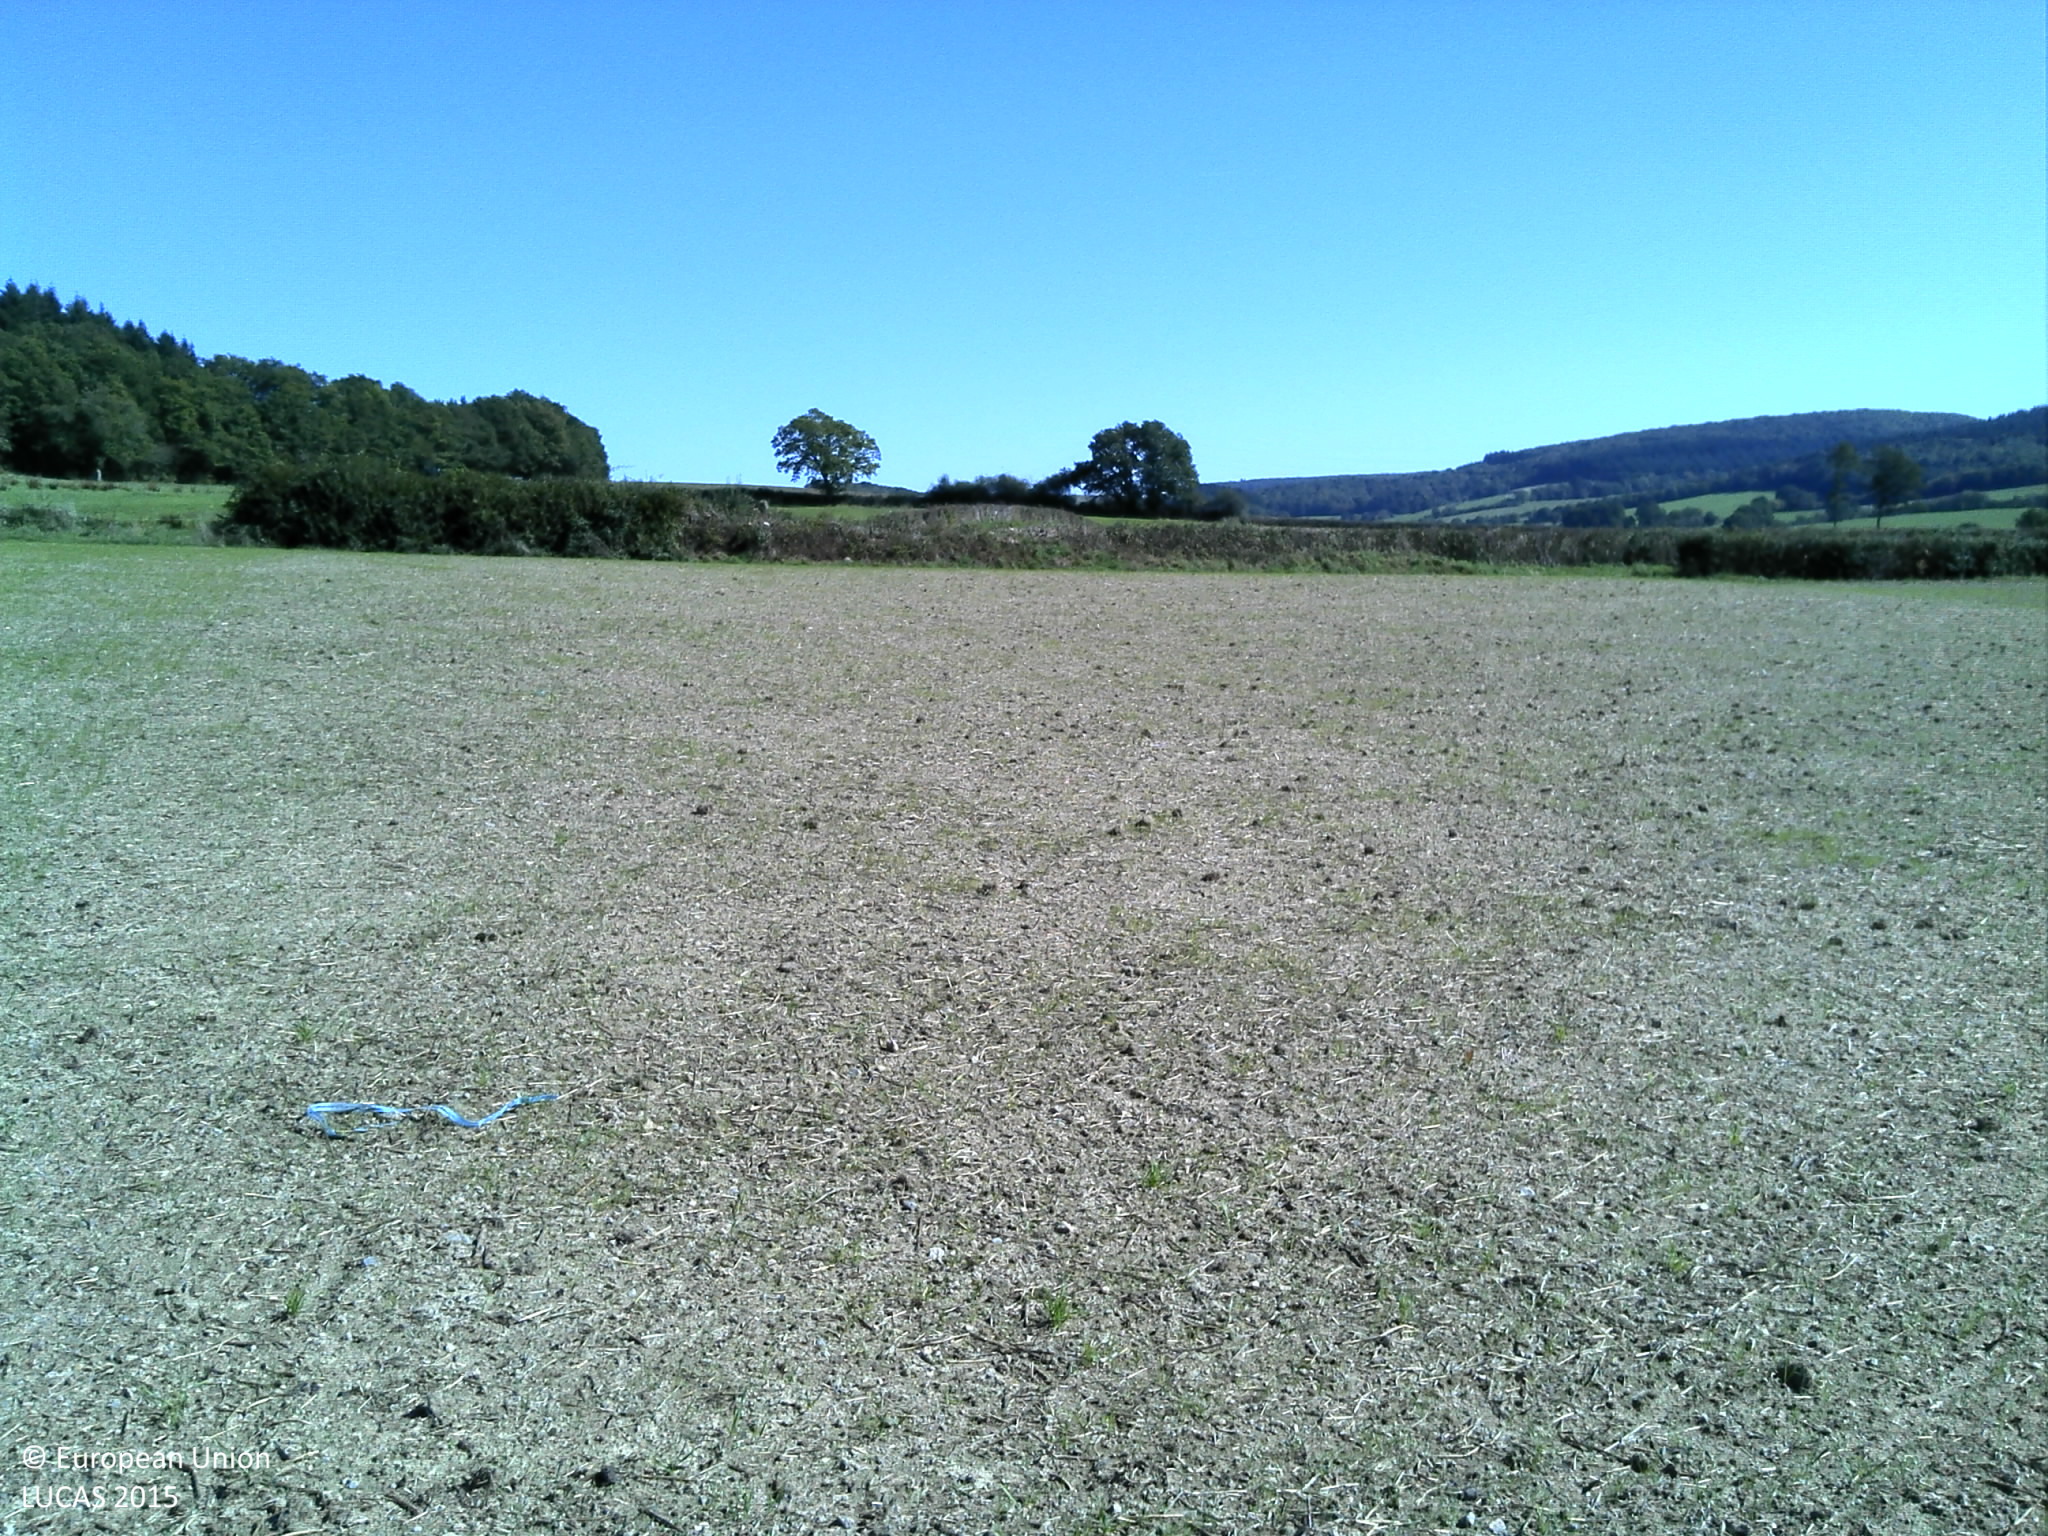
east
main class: Cropland
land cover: Common wheat
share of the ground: < 10 %
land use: Agriculture (excluding fallow land and kitchen gardens)
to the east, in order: Common wheat; Tracks; Managed hedges; Spontaneously vegetated surfaces; Managed hedges; Grassland without tree/shrub cover
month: September
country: FR
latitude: 46.9786
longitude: 4.3603
